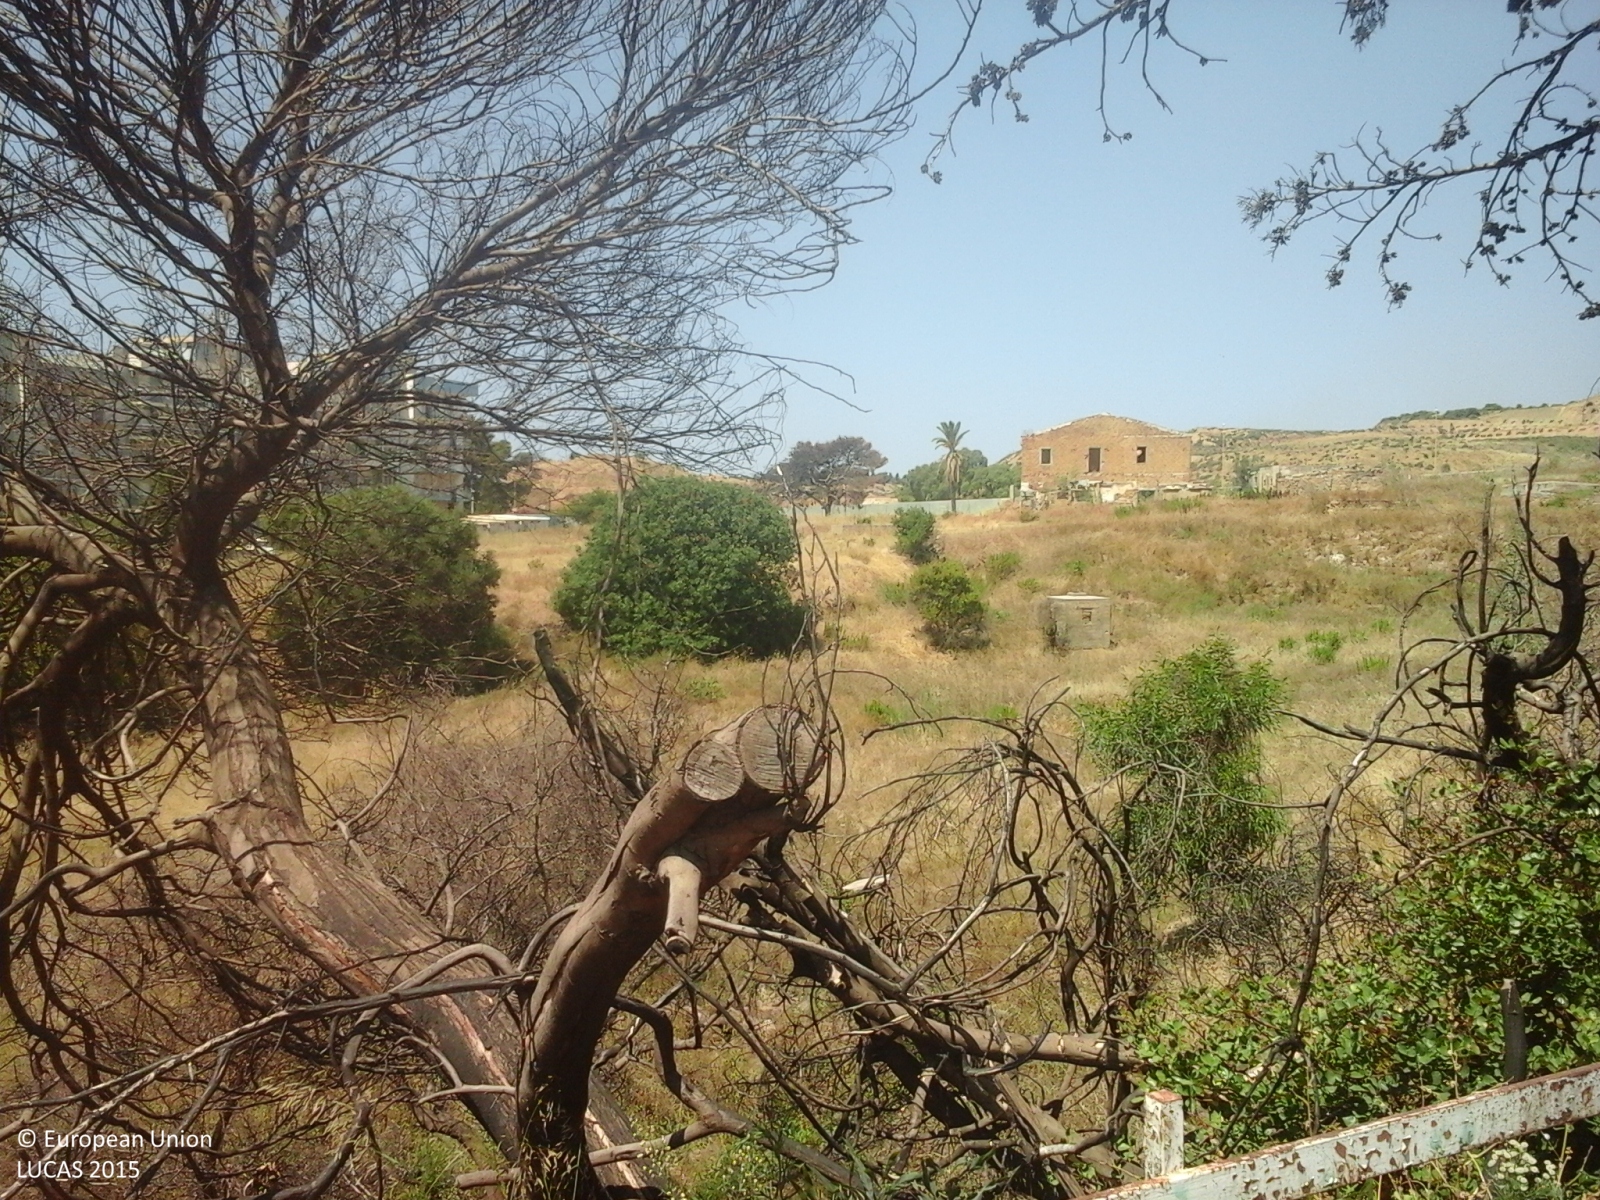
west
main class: Grassland
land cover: Grassland without tree/shrub cover
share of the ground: > 75 %
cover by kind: herbaceous plants 100 %
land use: Abandoned areas
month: July
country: IT
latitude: 37.2997
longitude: 13.5485
